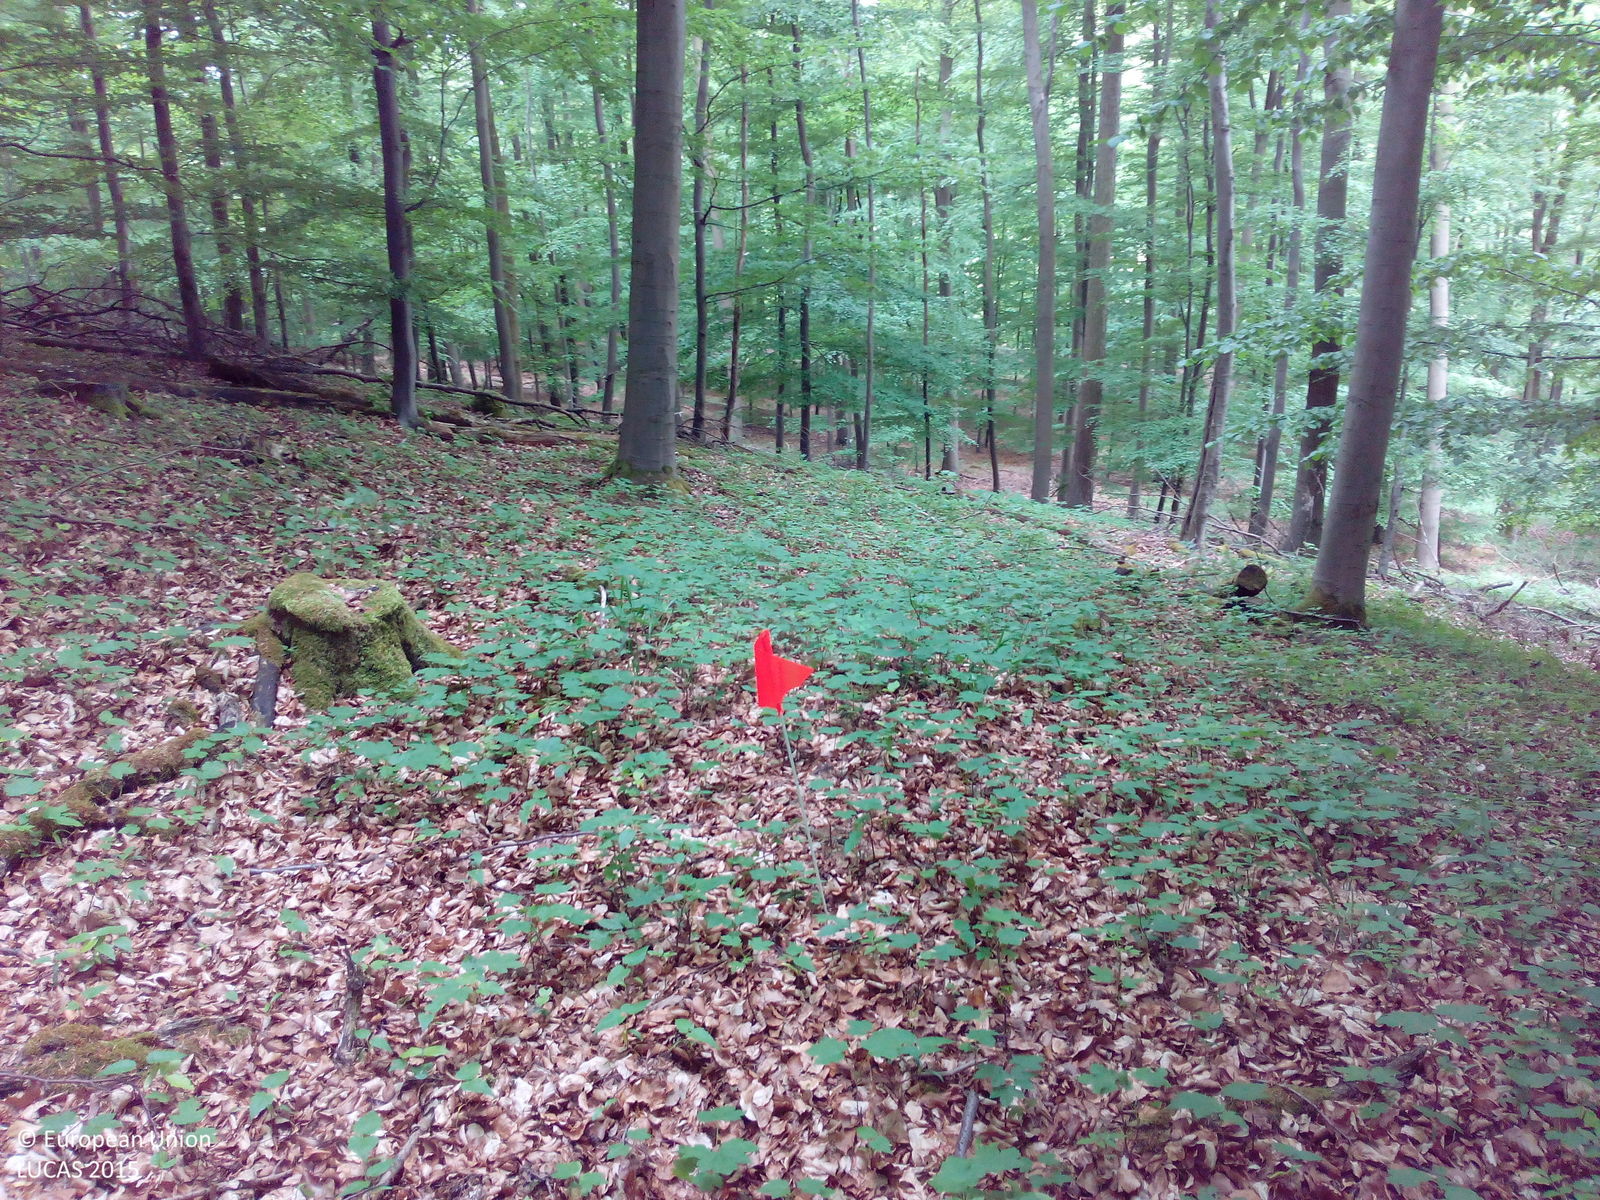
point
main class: Woodland
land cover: Broadleaved woodland
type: beech forest
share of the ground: > 75 %
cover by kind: broadleaved forest trees 90 %, coniferous forest trees 10 %
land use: Forestry
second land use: Amenities, museums, leisure
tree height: > 5 m
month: May
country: DE
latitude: 51.8377
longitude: 9.6663
